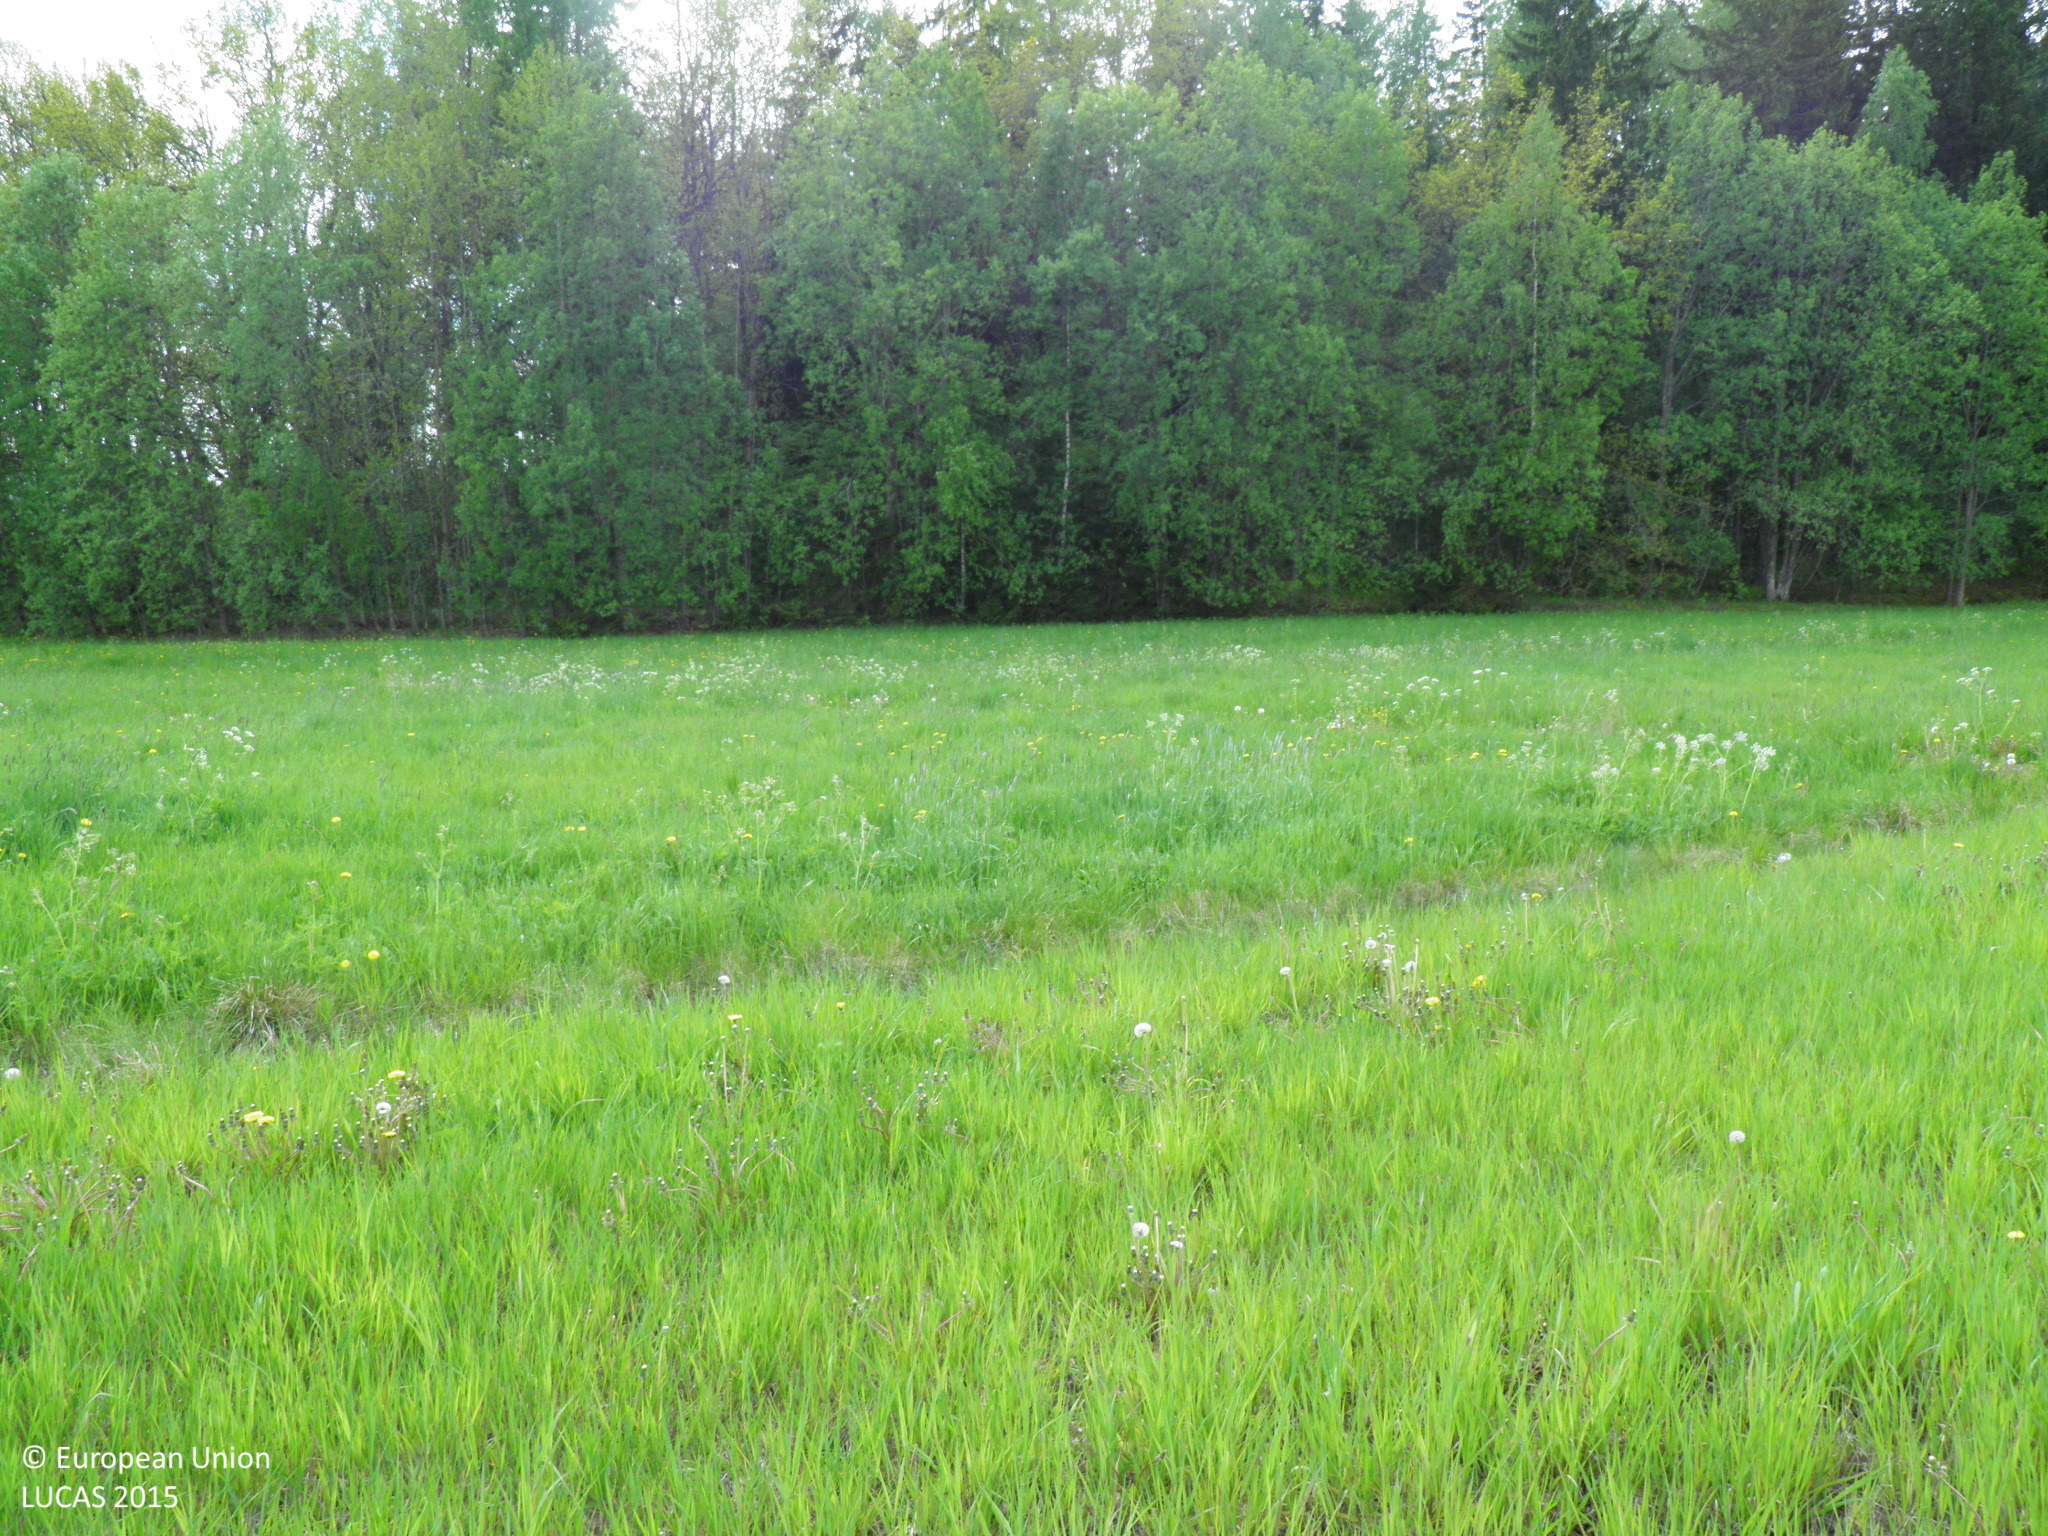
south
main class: Cropland
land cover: Temporary grasslands
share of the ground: > 75 %
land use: Agriculture (excluding fallow land and kitchen gardens)
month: May
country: FI
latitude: 60.4109
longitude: 22.2496
